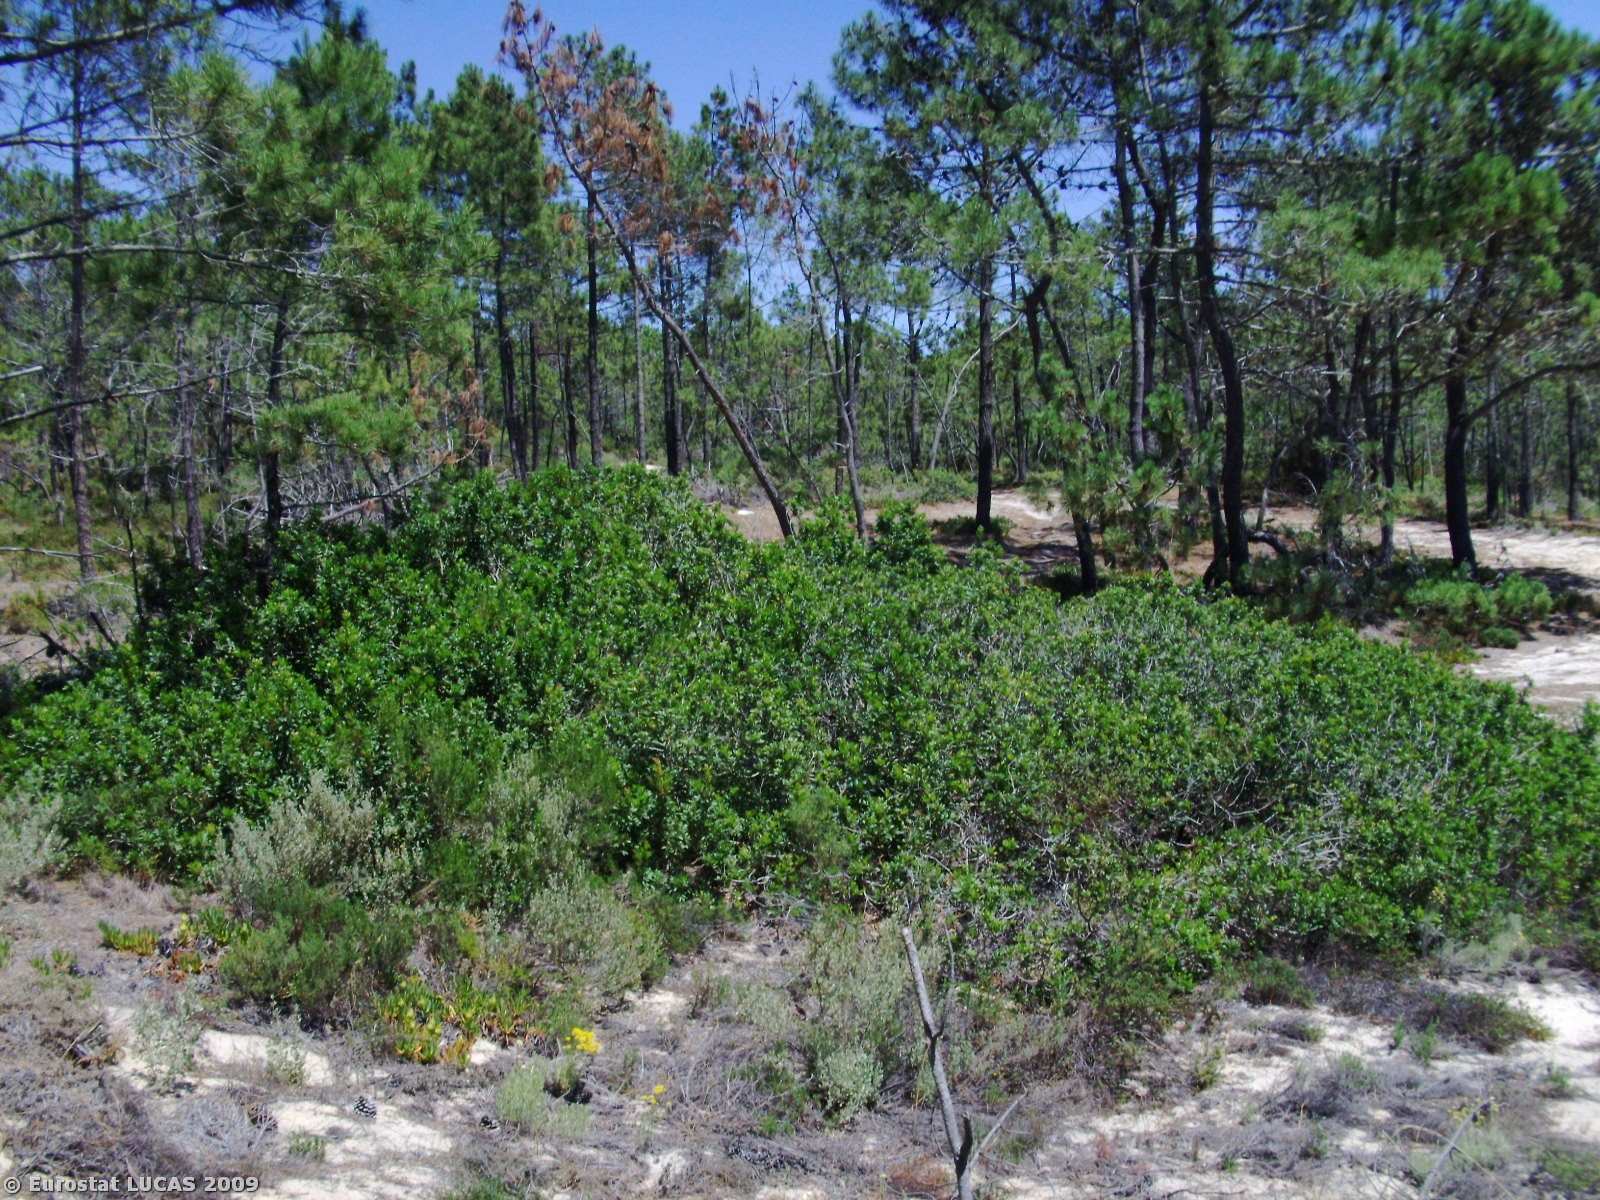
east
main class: Woodland
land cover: Coniferous woodland
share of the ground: > 75 %
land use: Unused
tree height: < 5 m
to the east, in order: Coniferous woodland; Tracks; Coniferous woodland; Tracks; Coniferous woodland; Tracks; Coniferous woodland
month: June
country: PT
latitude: 38.2141
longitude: -8.7741
